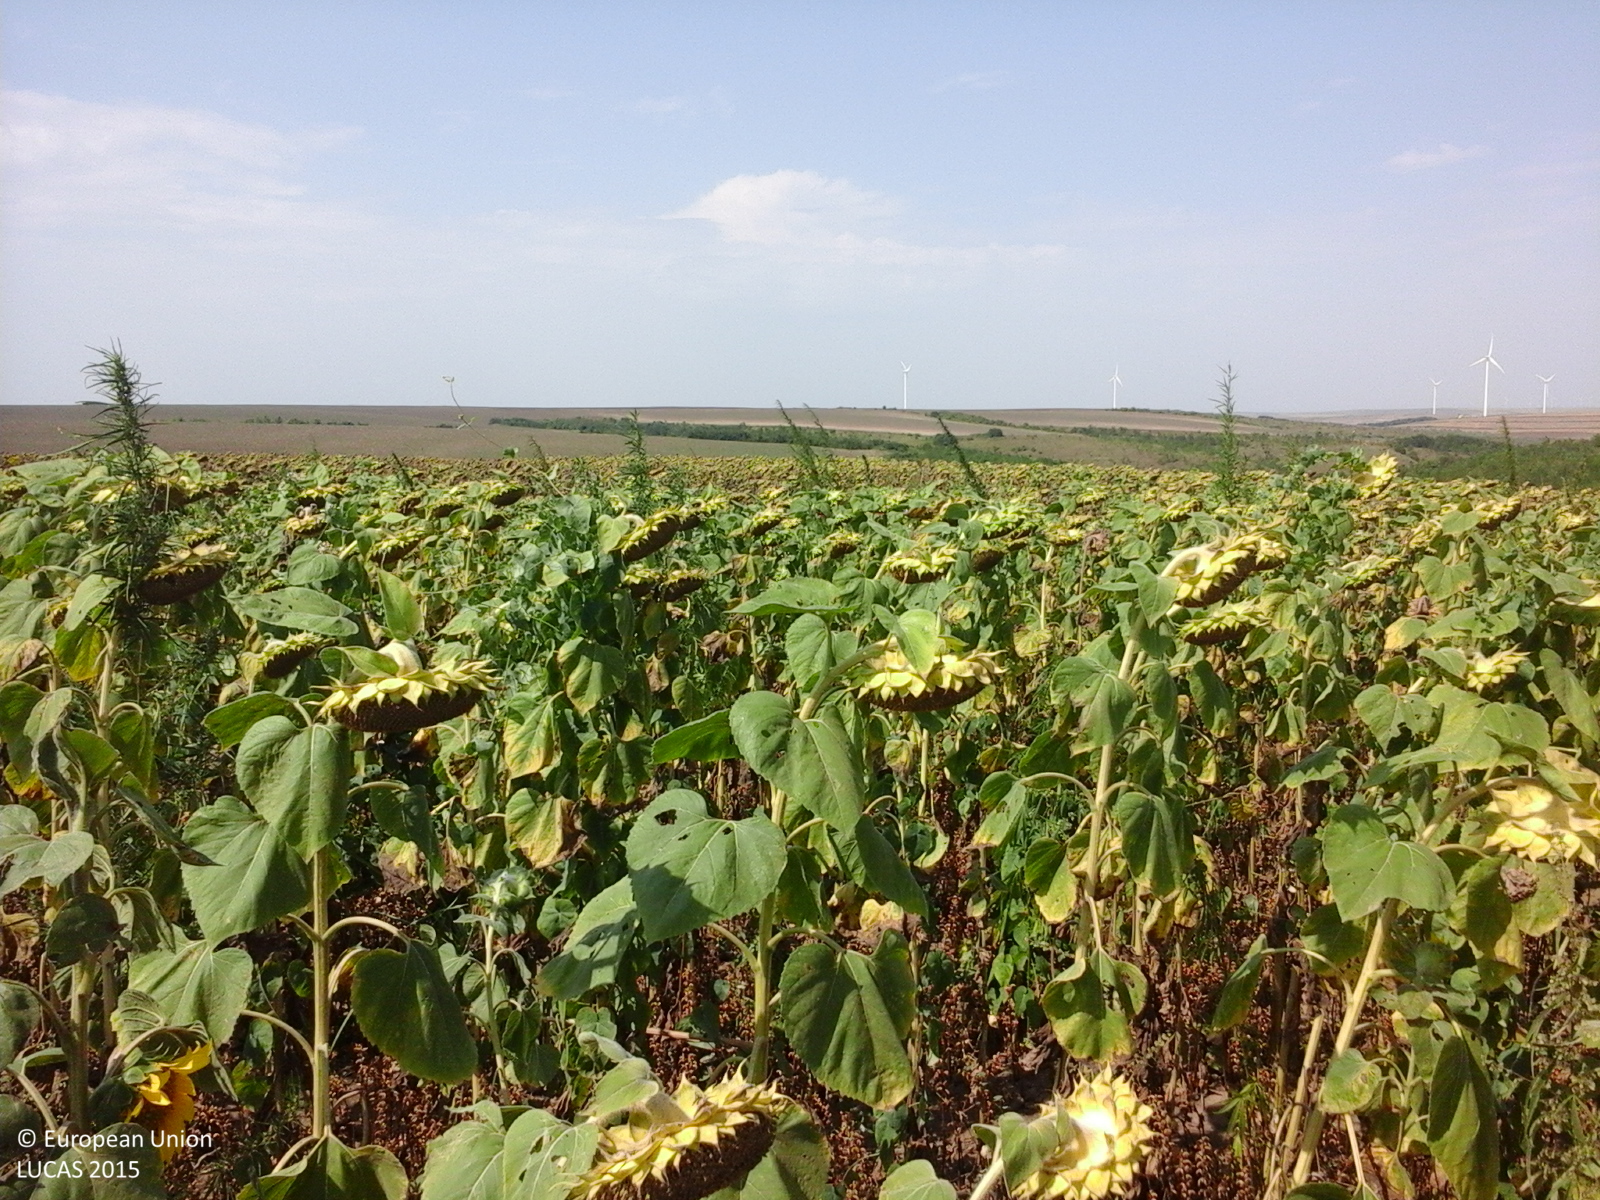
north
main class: Cropland
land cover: Sunflower
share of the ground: > 75 %
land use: Agriculture (excluding fallow land and kitchen gardens)
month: August
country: RO
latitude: 44.1800
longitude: 28.0042
